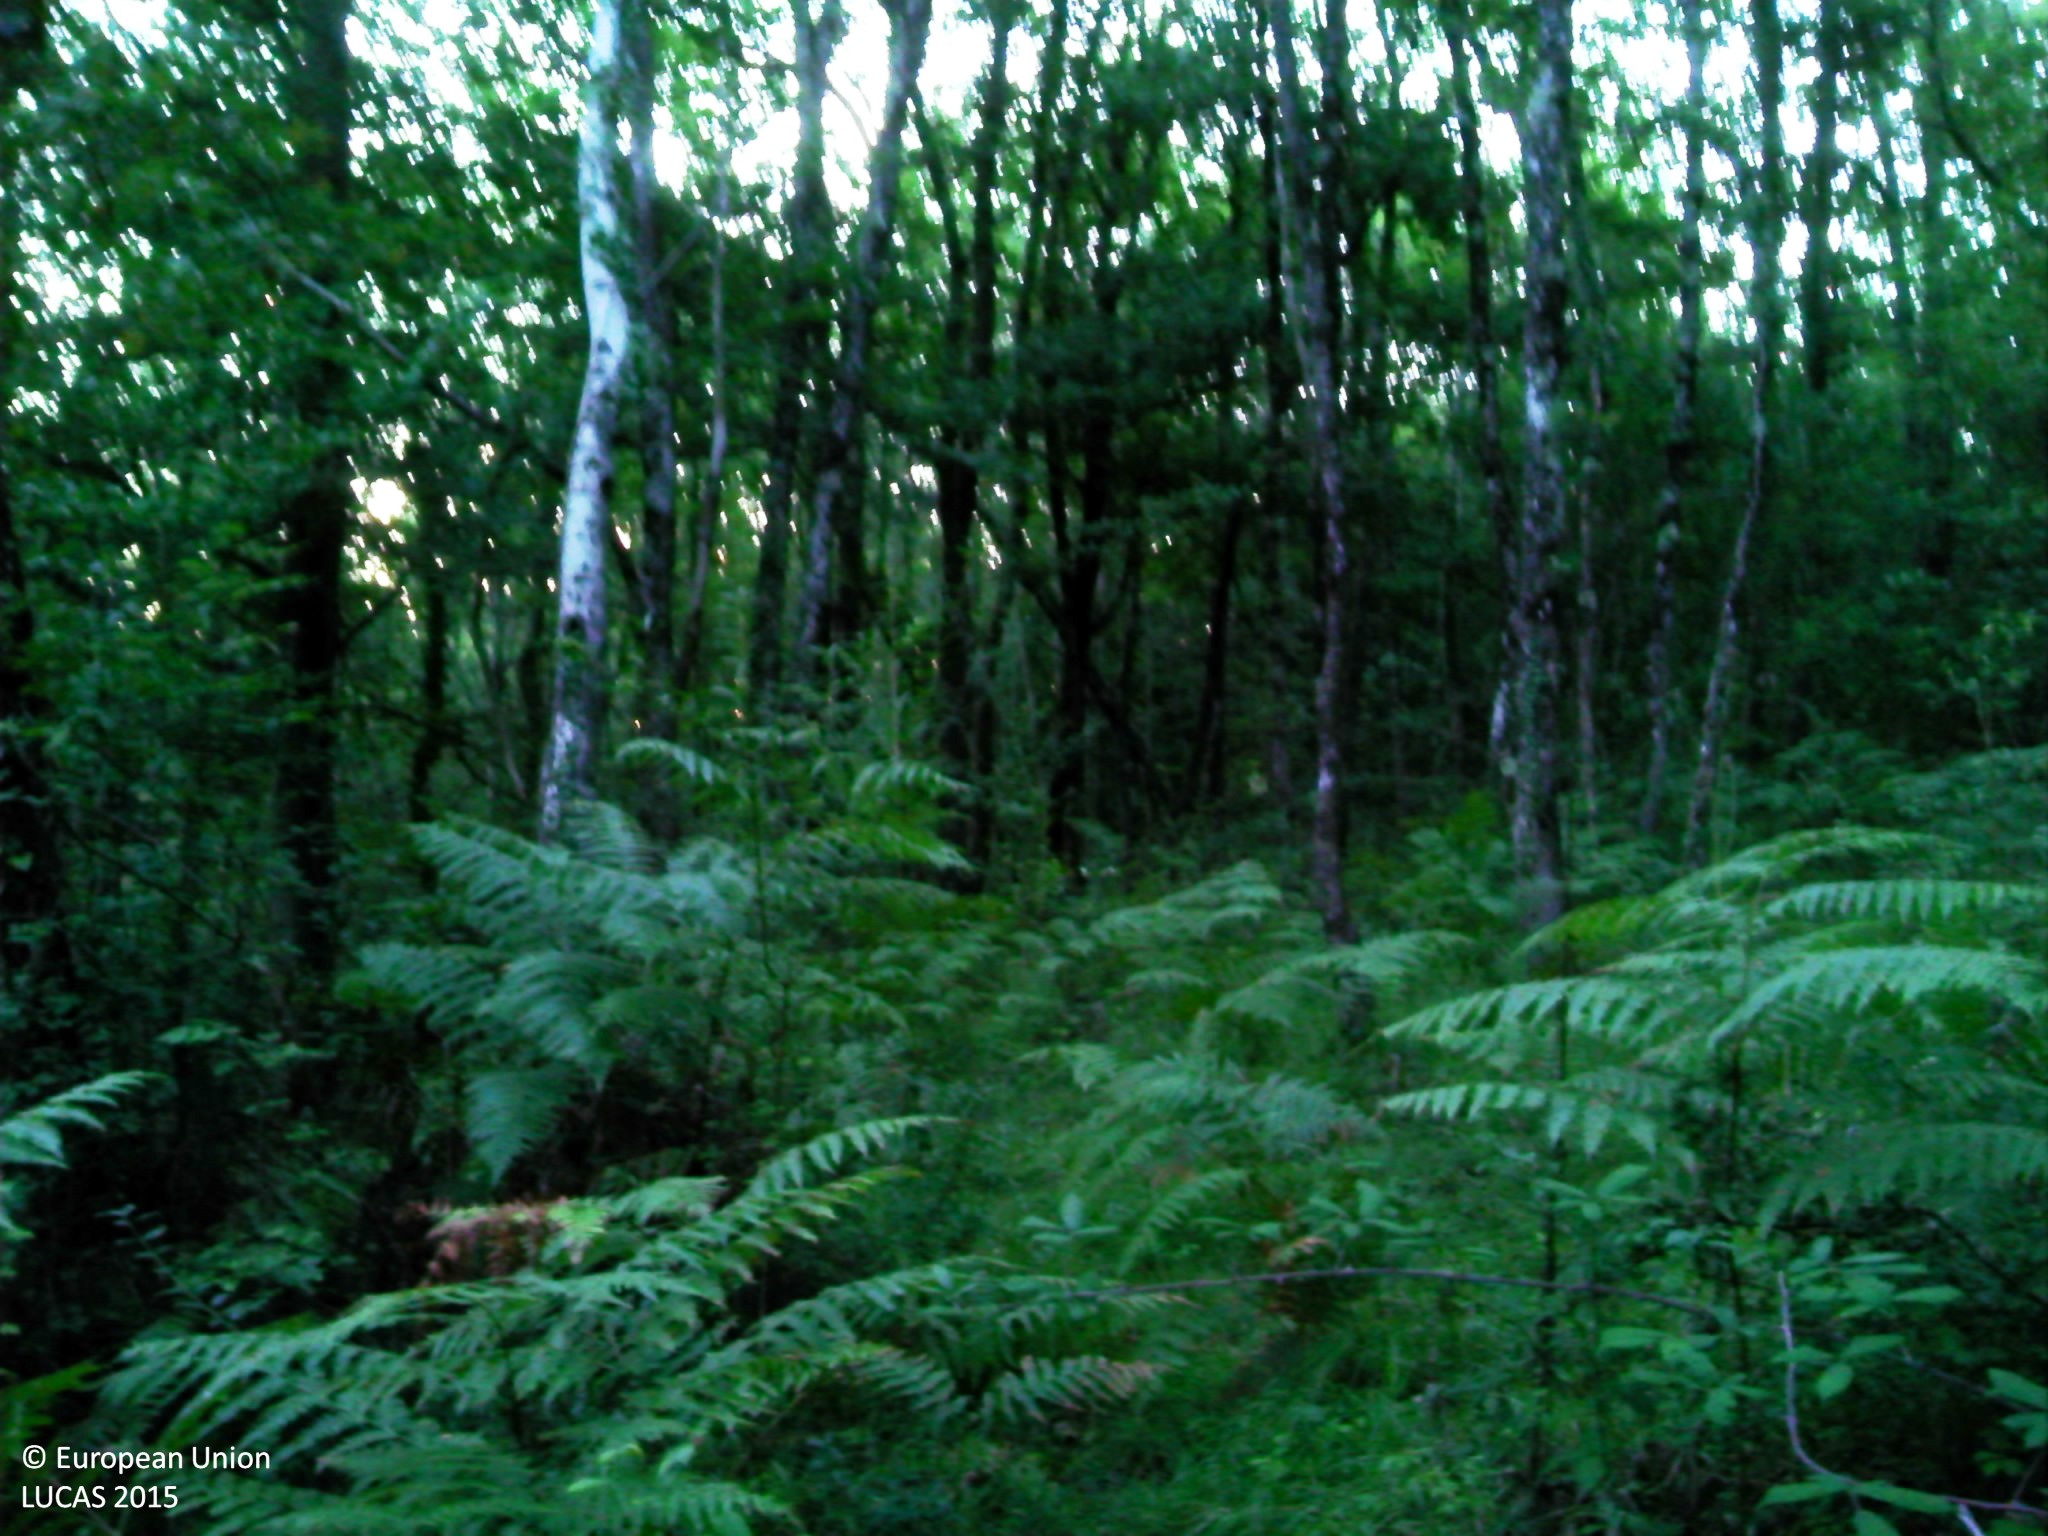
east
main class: Woodland
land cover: Broadleaved woodland
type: mesophytic deciduous forest
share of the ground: > 75 %
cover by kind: broadleaved forest trees 90 %, herbaceous plants 10 %
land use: Agriculture (excluding fallow land and kitchen gardens)
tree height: > 5 m
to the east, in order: Broadleaved woodland; Grassland with sparse tree/shrub cover; Broadleaved woodland; Tracks; Broadleaved woodland; Fences; Broadleaved woodland
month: August
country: FR
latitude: 42.9745
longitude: 1.8045
